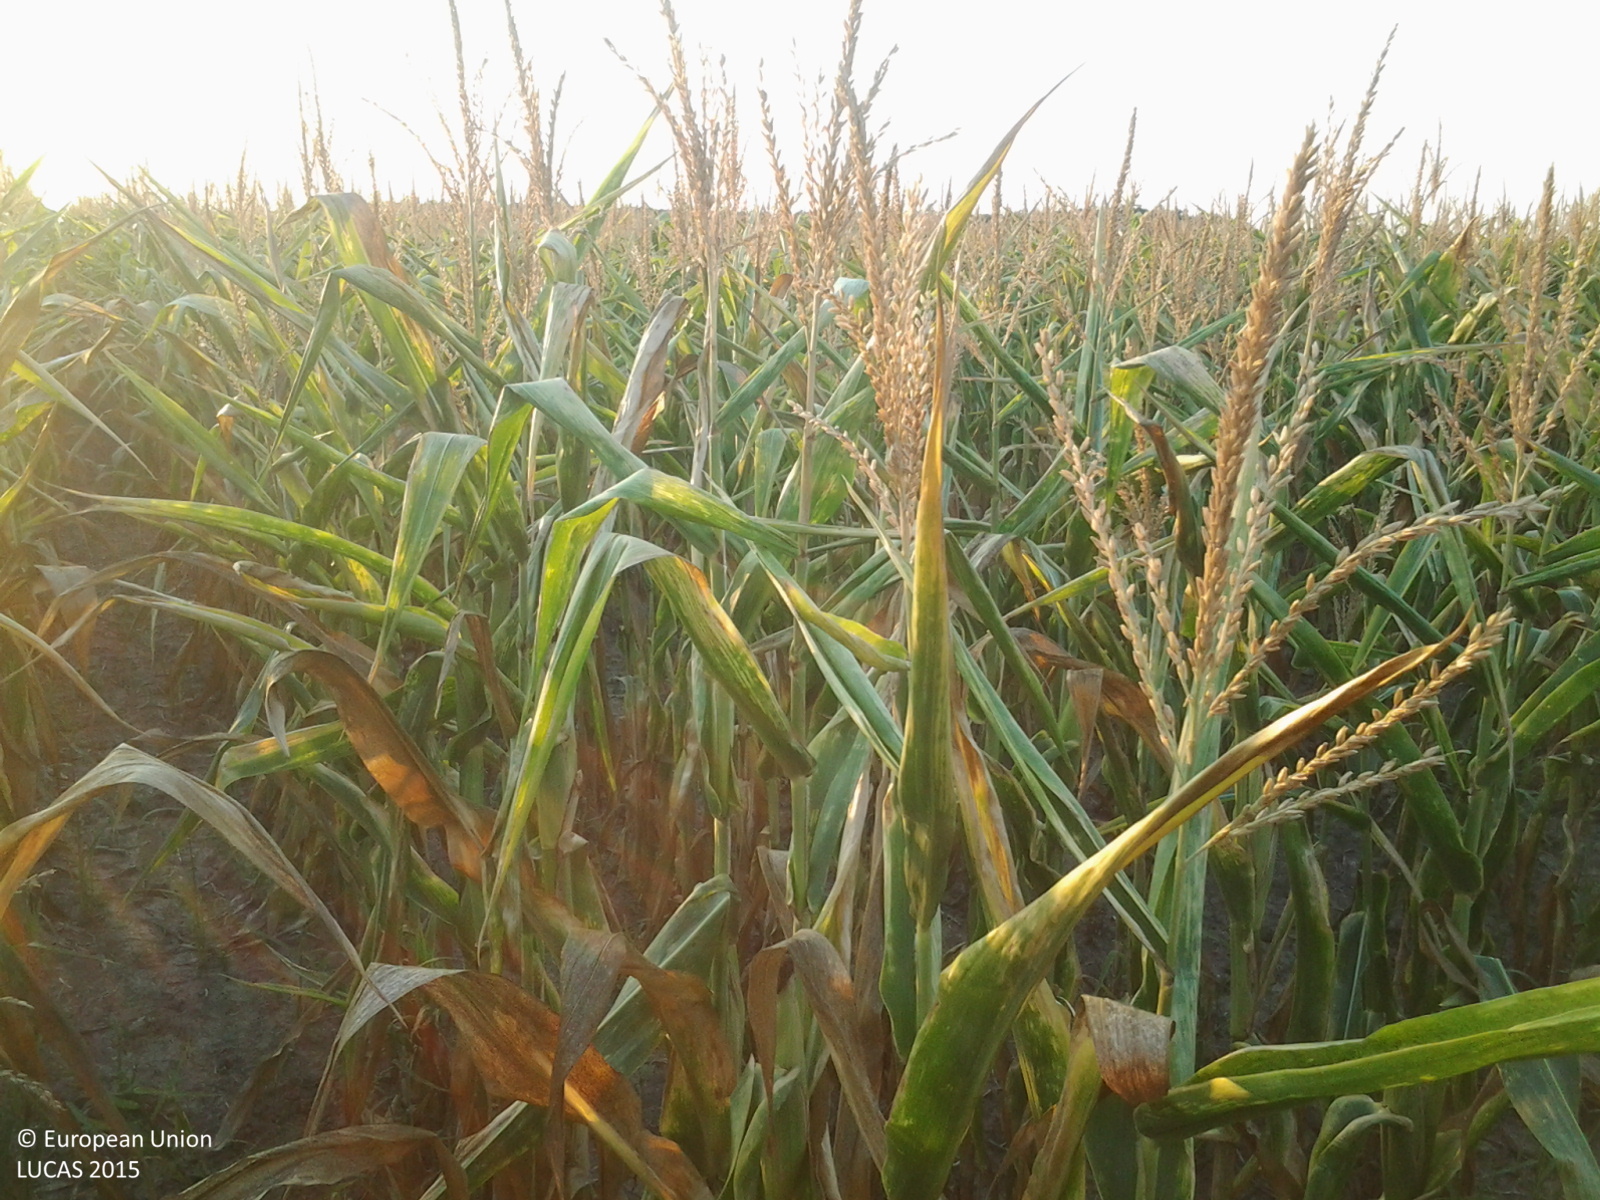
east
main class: Cropland
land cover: Maize
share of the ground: > 75 %
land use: Agriculture (excluding fallow land and kitchen gardens)
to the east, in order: Maize; Abandoned hedges; Inland fresh running water; Abandoned hedges; Common wheat
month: August
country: HU
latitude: 46.8665
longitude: 21.5718
